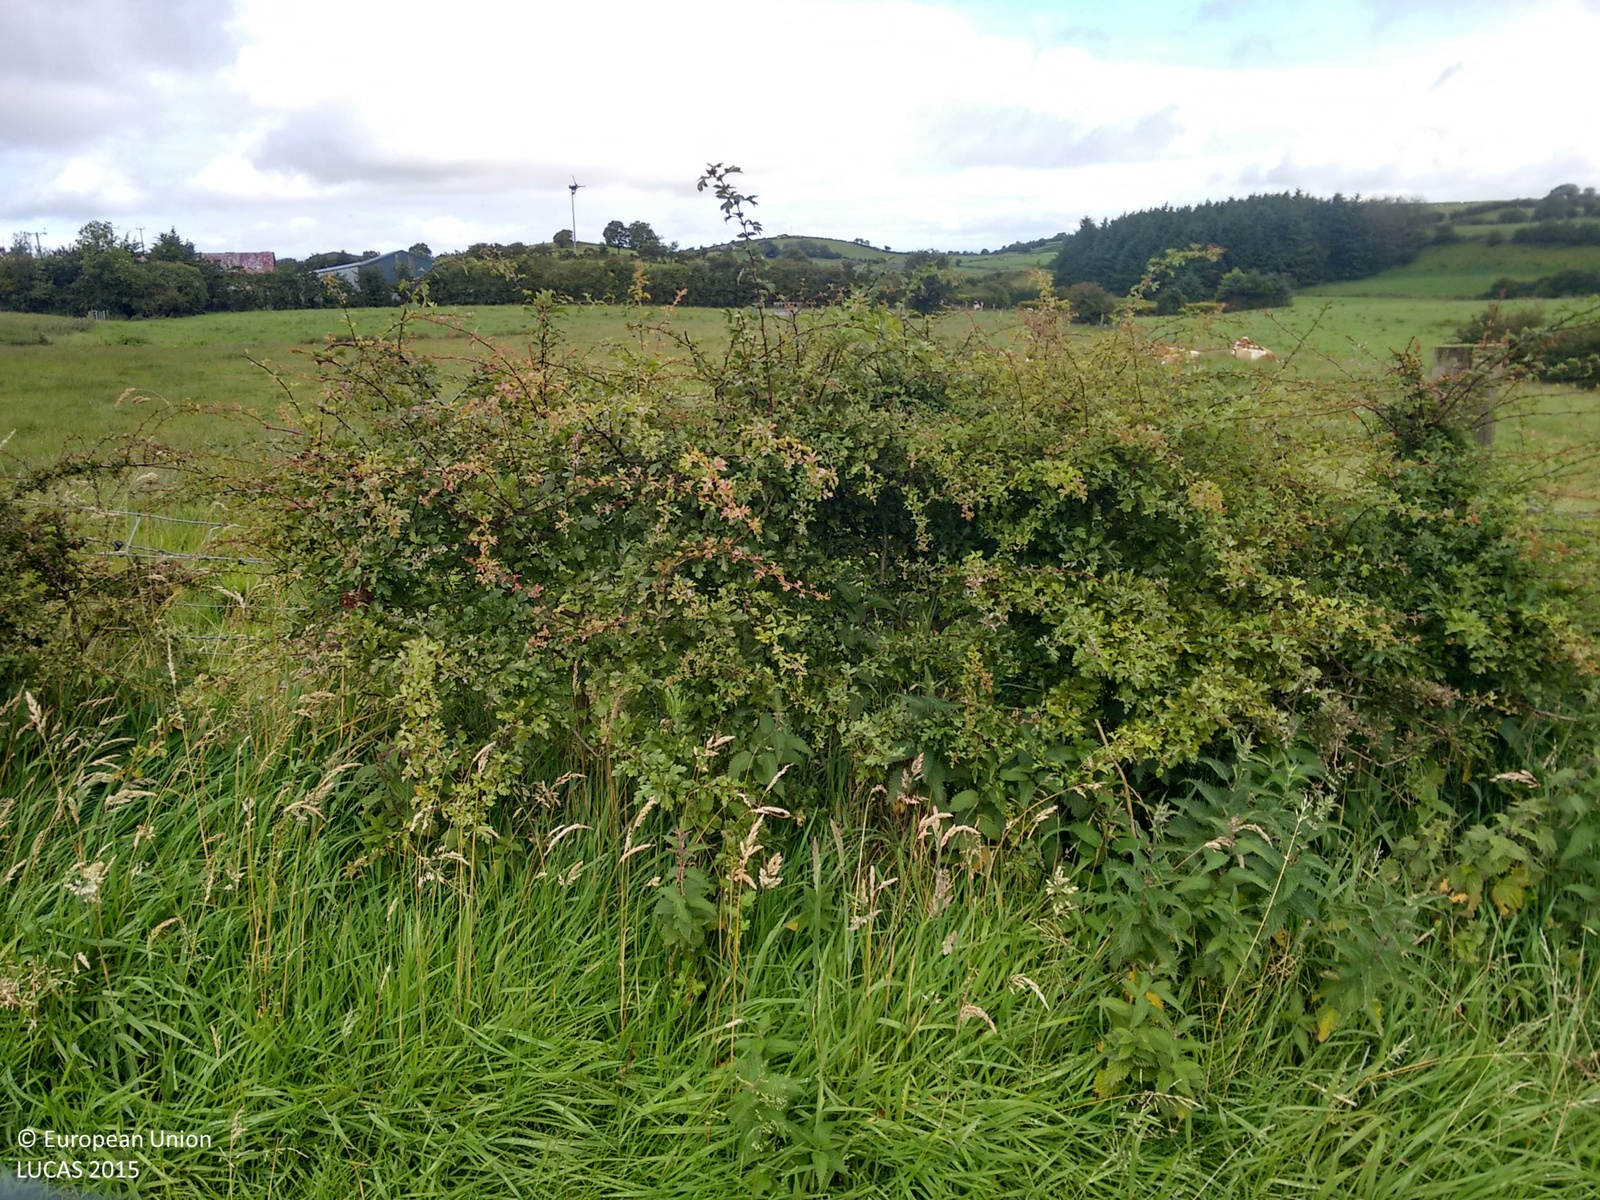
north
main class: Grassland
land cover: Grassland without tree/shrub cover
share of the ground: > 75 %
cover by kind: herbaceous plants 100 %
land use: Agriculture (excluding fallow land and kitchen gardens)
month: August
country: GB
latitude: 54.2152
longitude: -6.7084
